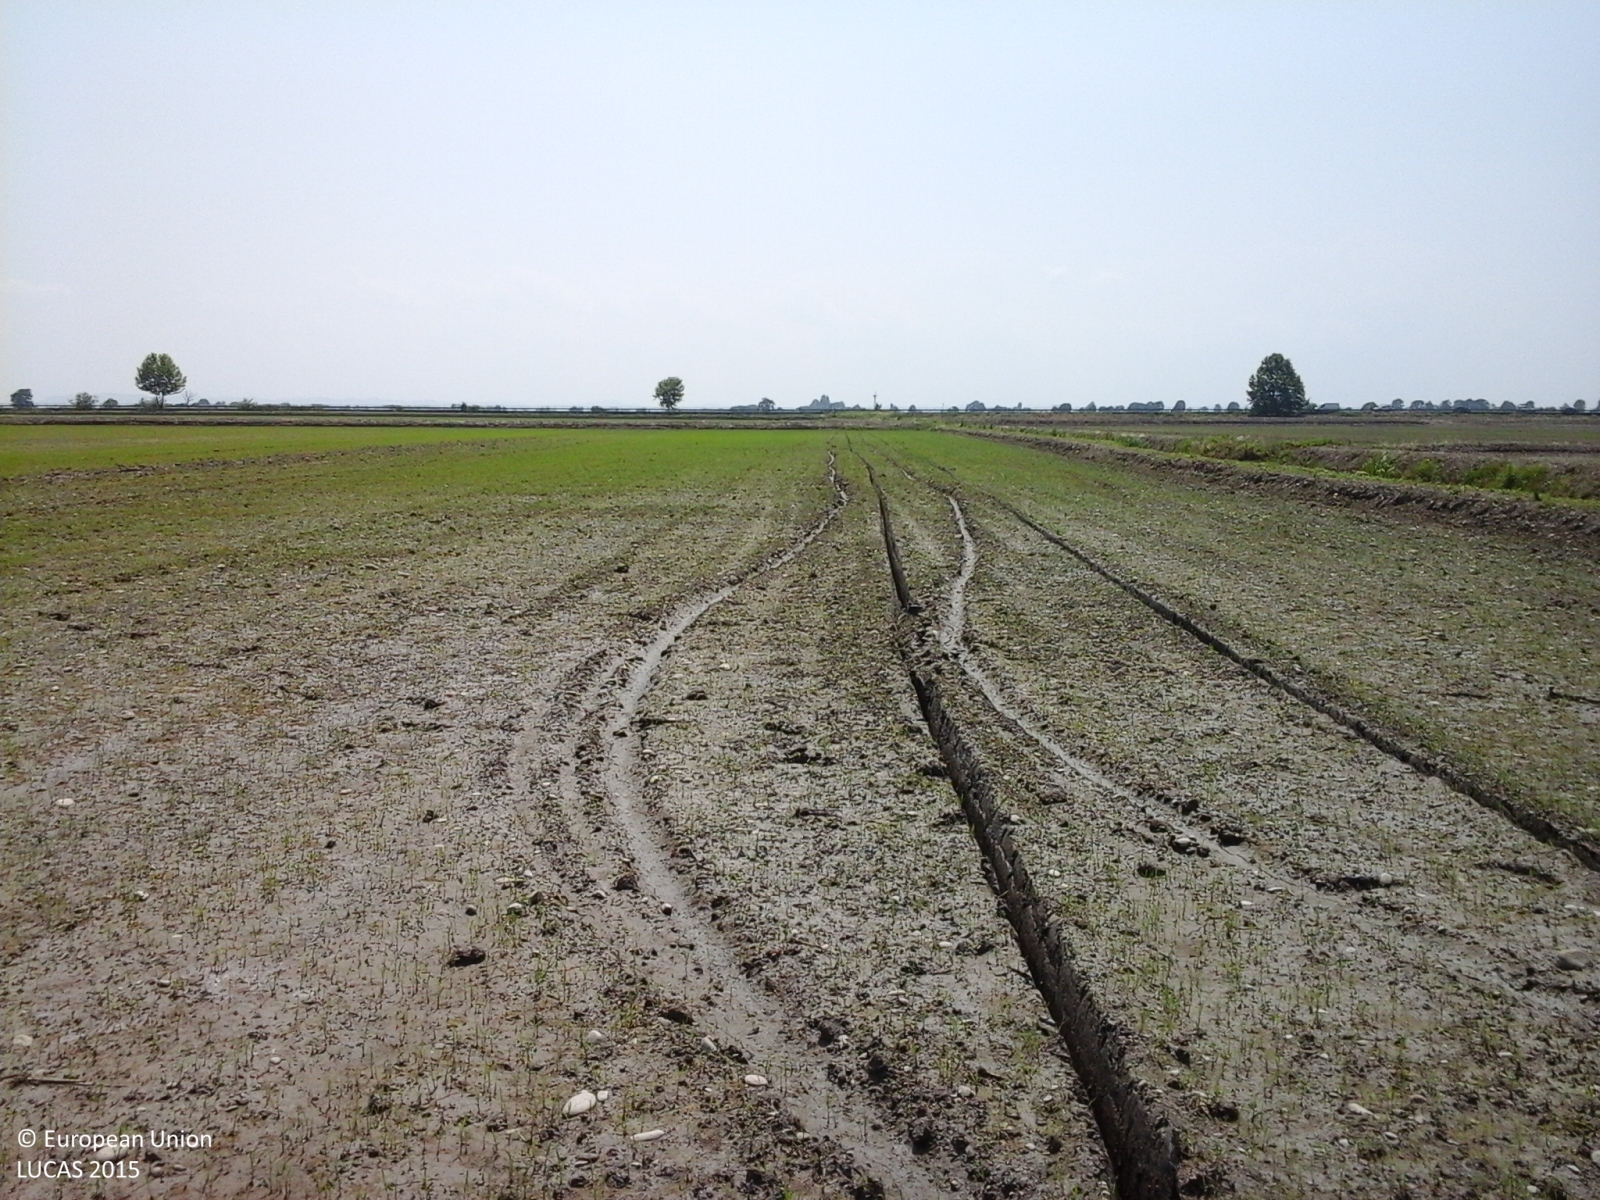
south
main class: Cropland
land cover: Rice
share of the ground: < 10 %
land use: Agriculture (excluding fallow land and kitchen gardens)
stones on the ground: < 10 %
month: May
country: IT
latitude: 45.3462
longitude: 8.2799
